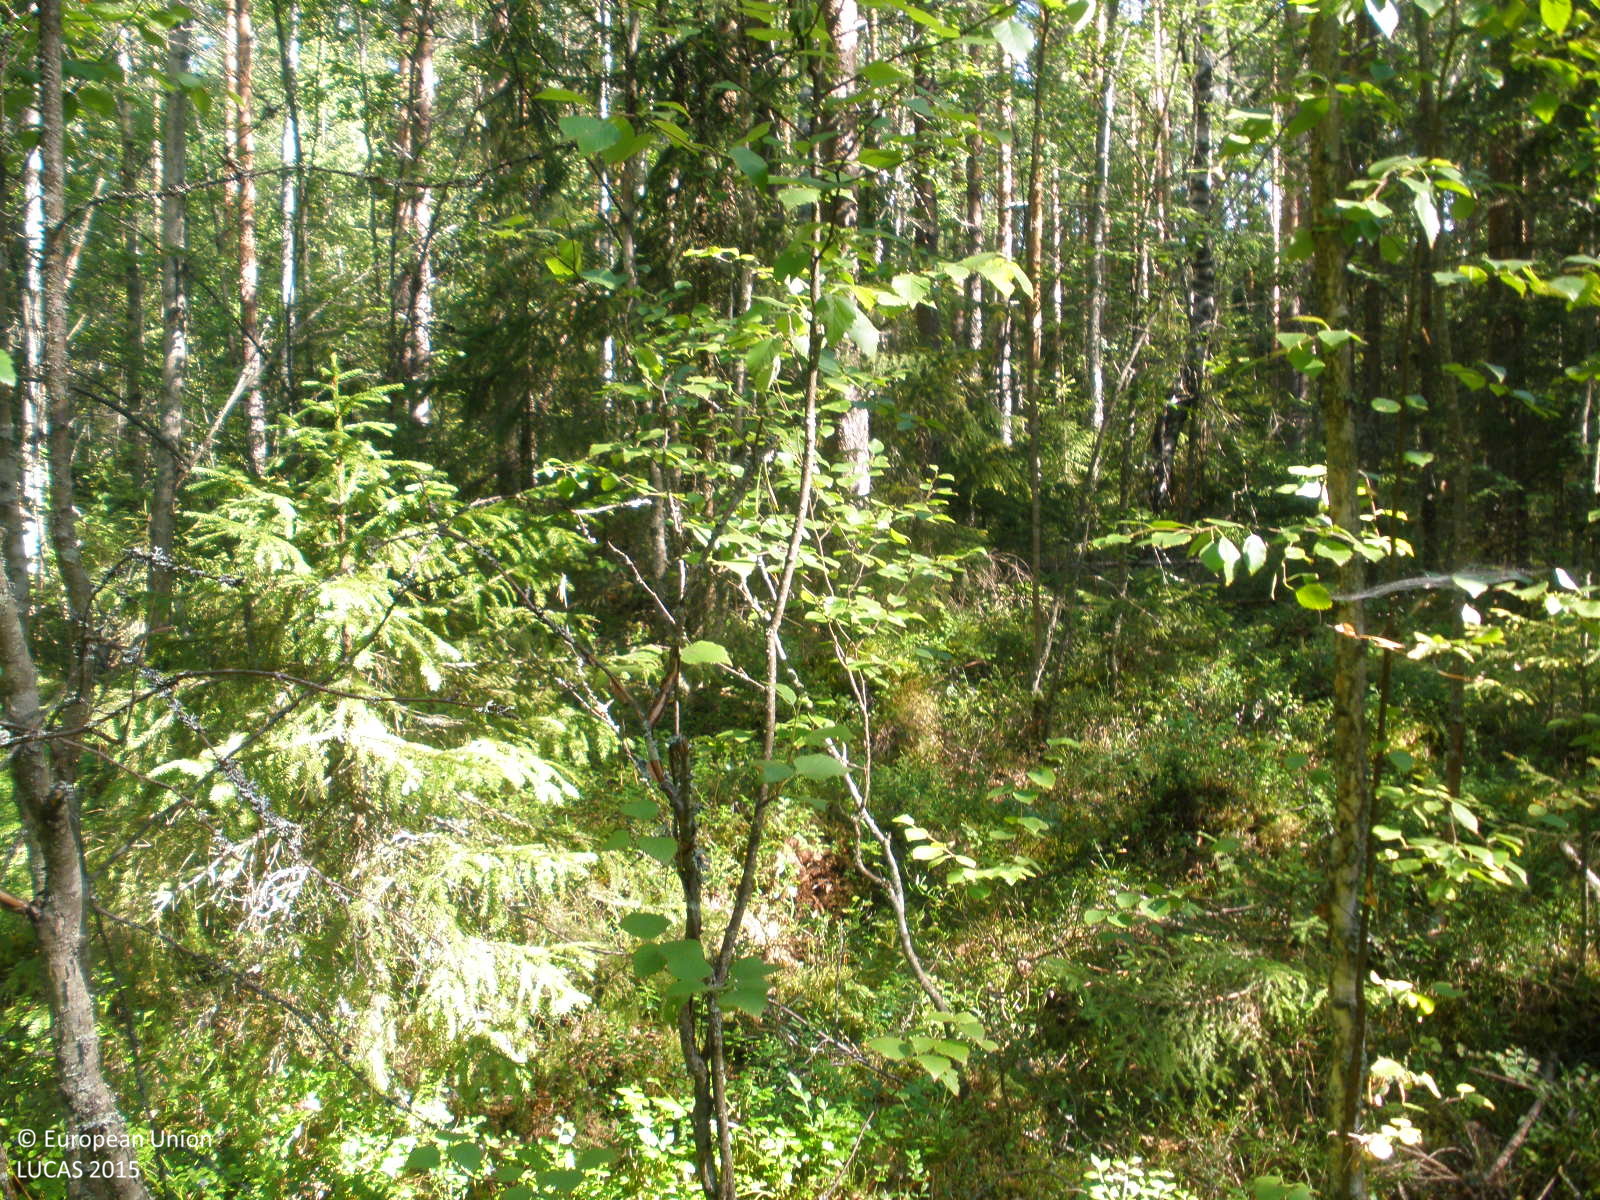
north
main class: Woodland
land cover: Pine dominated mixed woodland
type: boreal forest
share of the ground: > 75 %
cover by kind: coniferous forest trees 60 %, broadleaved forest trees 25 %, shrubs 5 %, herbaceous plants 5 %, lichens and mosses 5 %
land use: Forestry
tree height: > 5 m
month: August
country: FI
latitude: 60.9489
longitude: 24.8613
